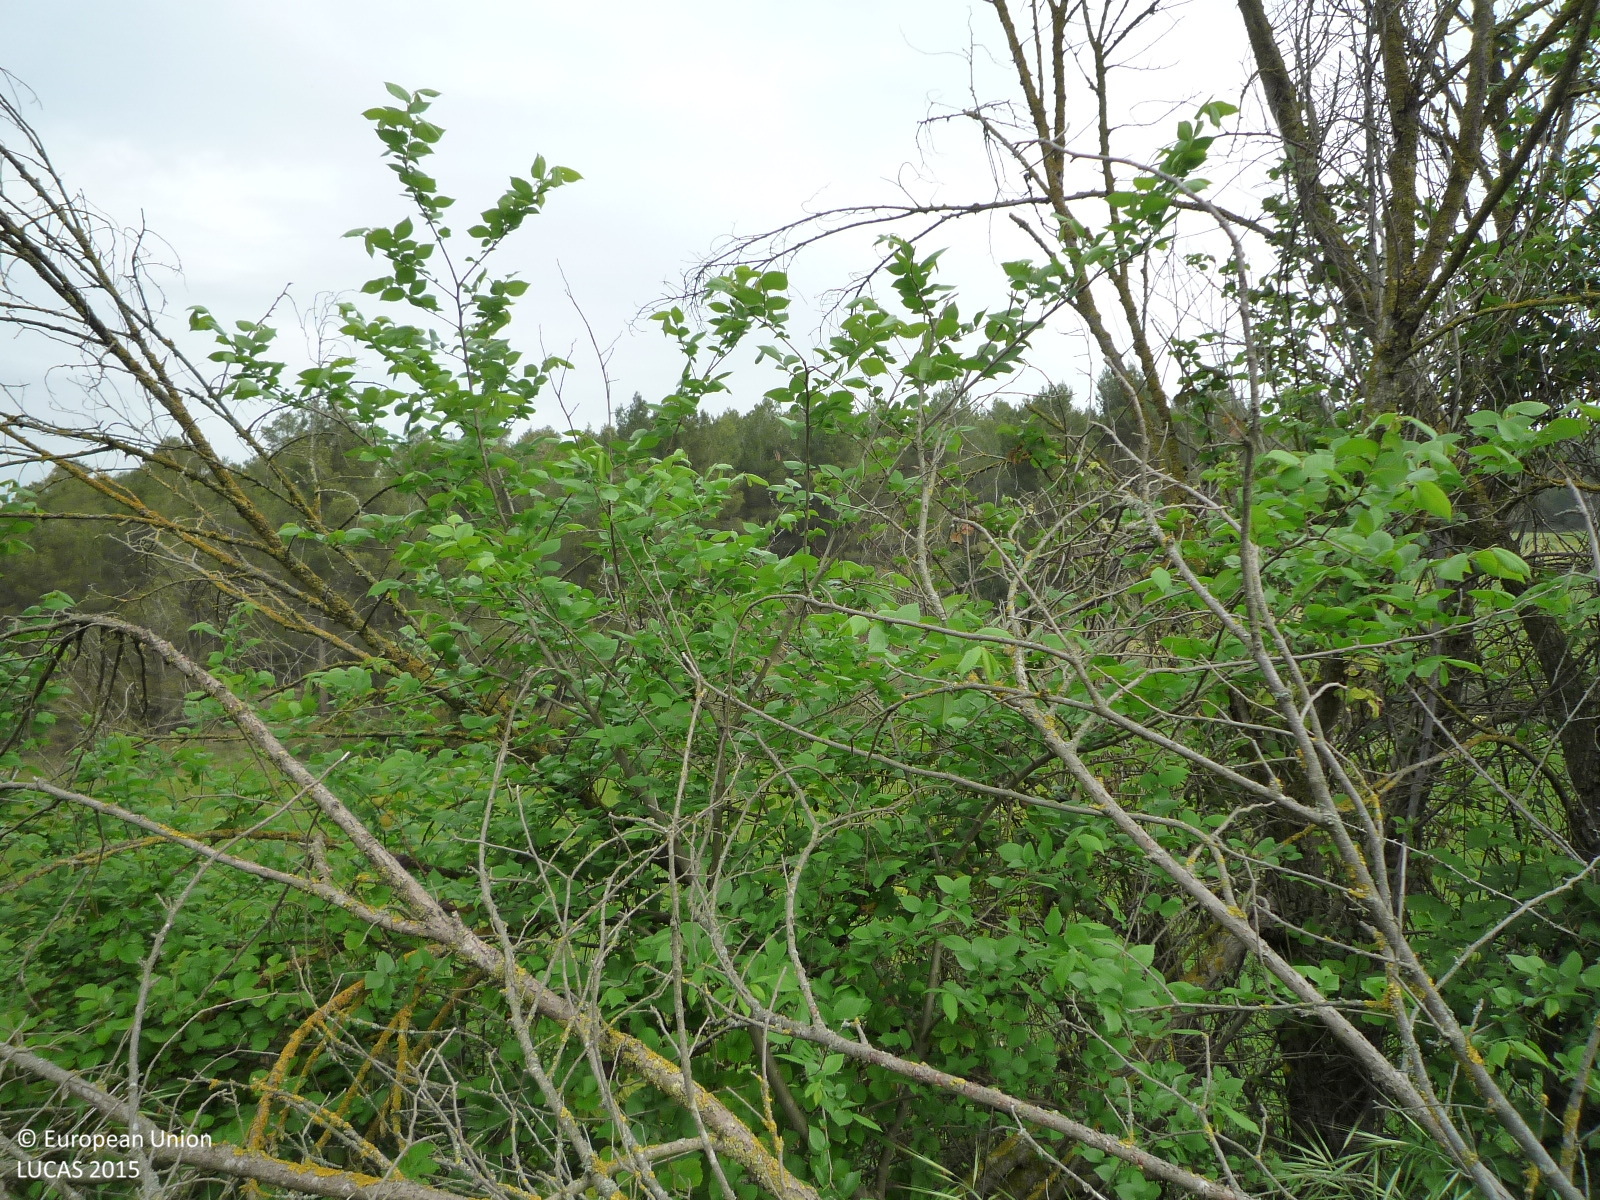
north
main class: Cropland
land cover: Barley
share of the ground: > 75 %
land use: Agriculture (excluding fallow land and kitchen gardens)
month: April
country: ES
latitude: 41.6190
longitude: 1.6504
